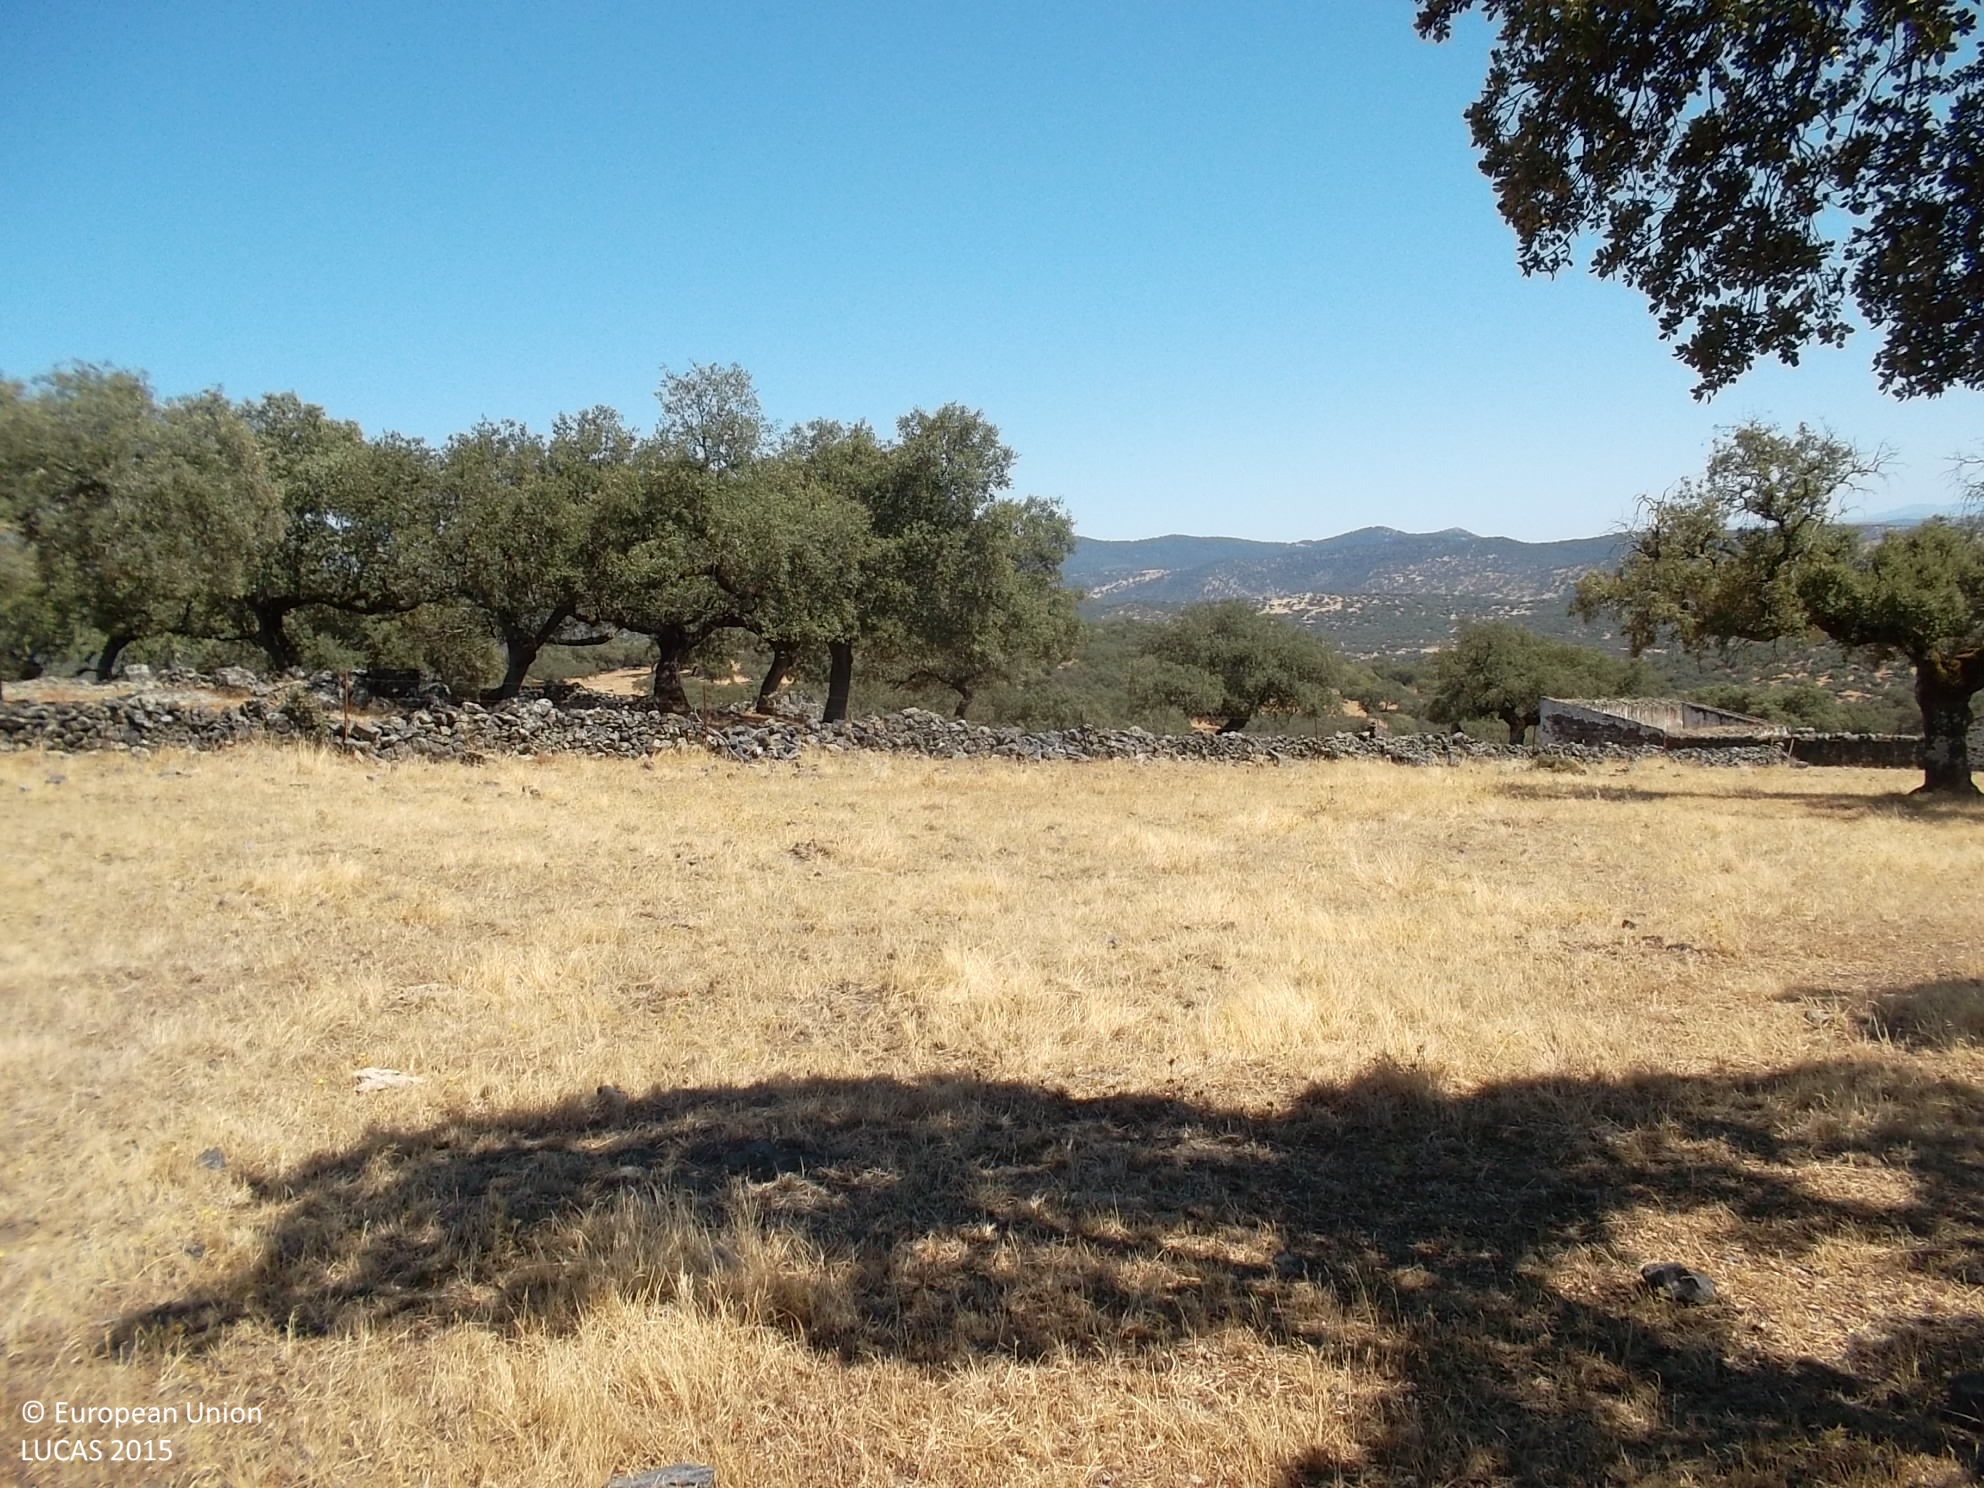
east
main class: Woodland
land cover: Broadleaved woodland
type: broadleaved evergreen forest
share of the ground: 10 - 25 %
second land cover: Grassland without tree/shrub cover
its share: > 75 %
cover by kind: herbaceous plants 85 %, broadleaved forest trees 15 %
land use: Forestry
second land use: Agriculture (excluding fallow land and kitchen gardens)
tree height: > 5 m
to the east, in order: Broadleaved woodland; Grassland without tree/shrub cover; Fences; Dry stone walls; Broadleaved woodland; Grassland with sparse tree/shrub cover; Grassland without tree/shrub cover; Grassland with sparse tree/shrub cover; Broadleaved woodland
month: August
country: ES
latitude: 38.4330
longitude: -6.7247
